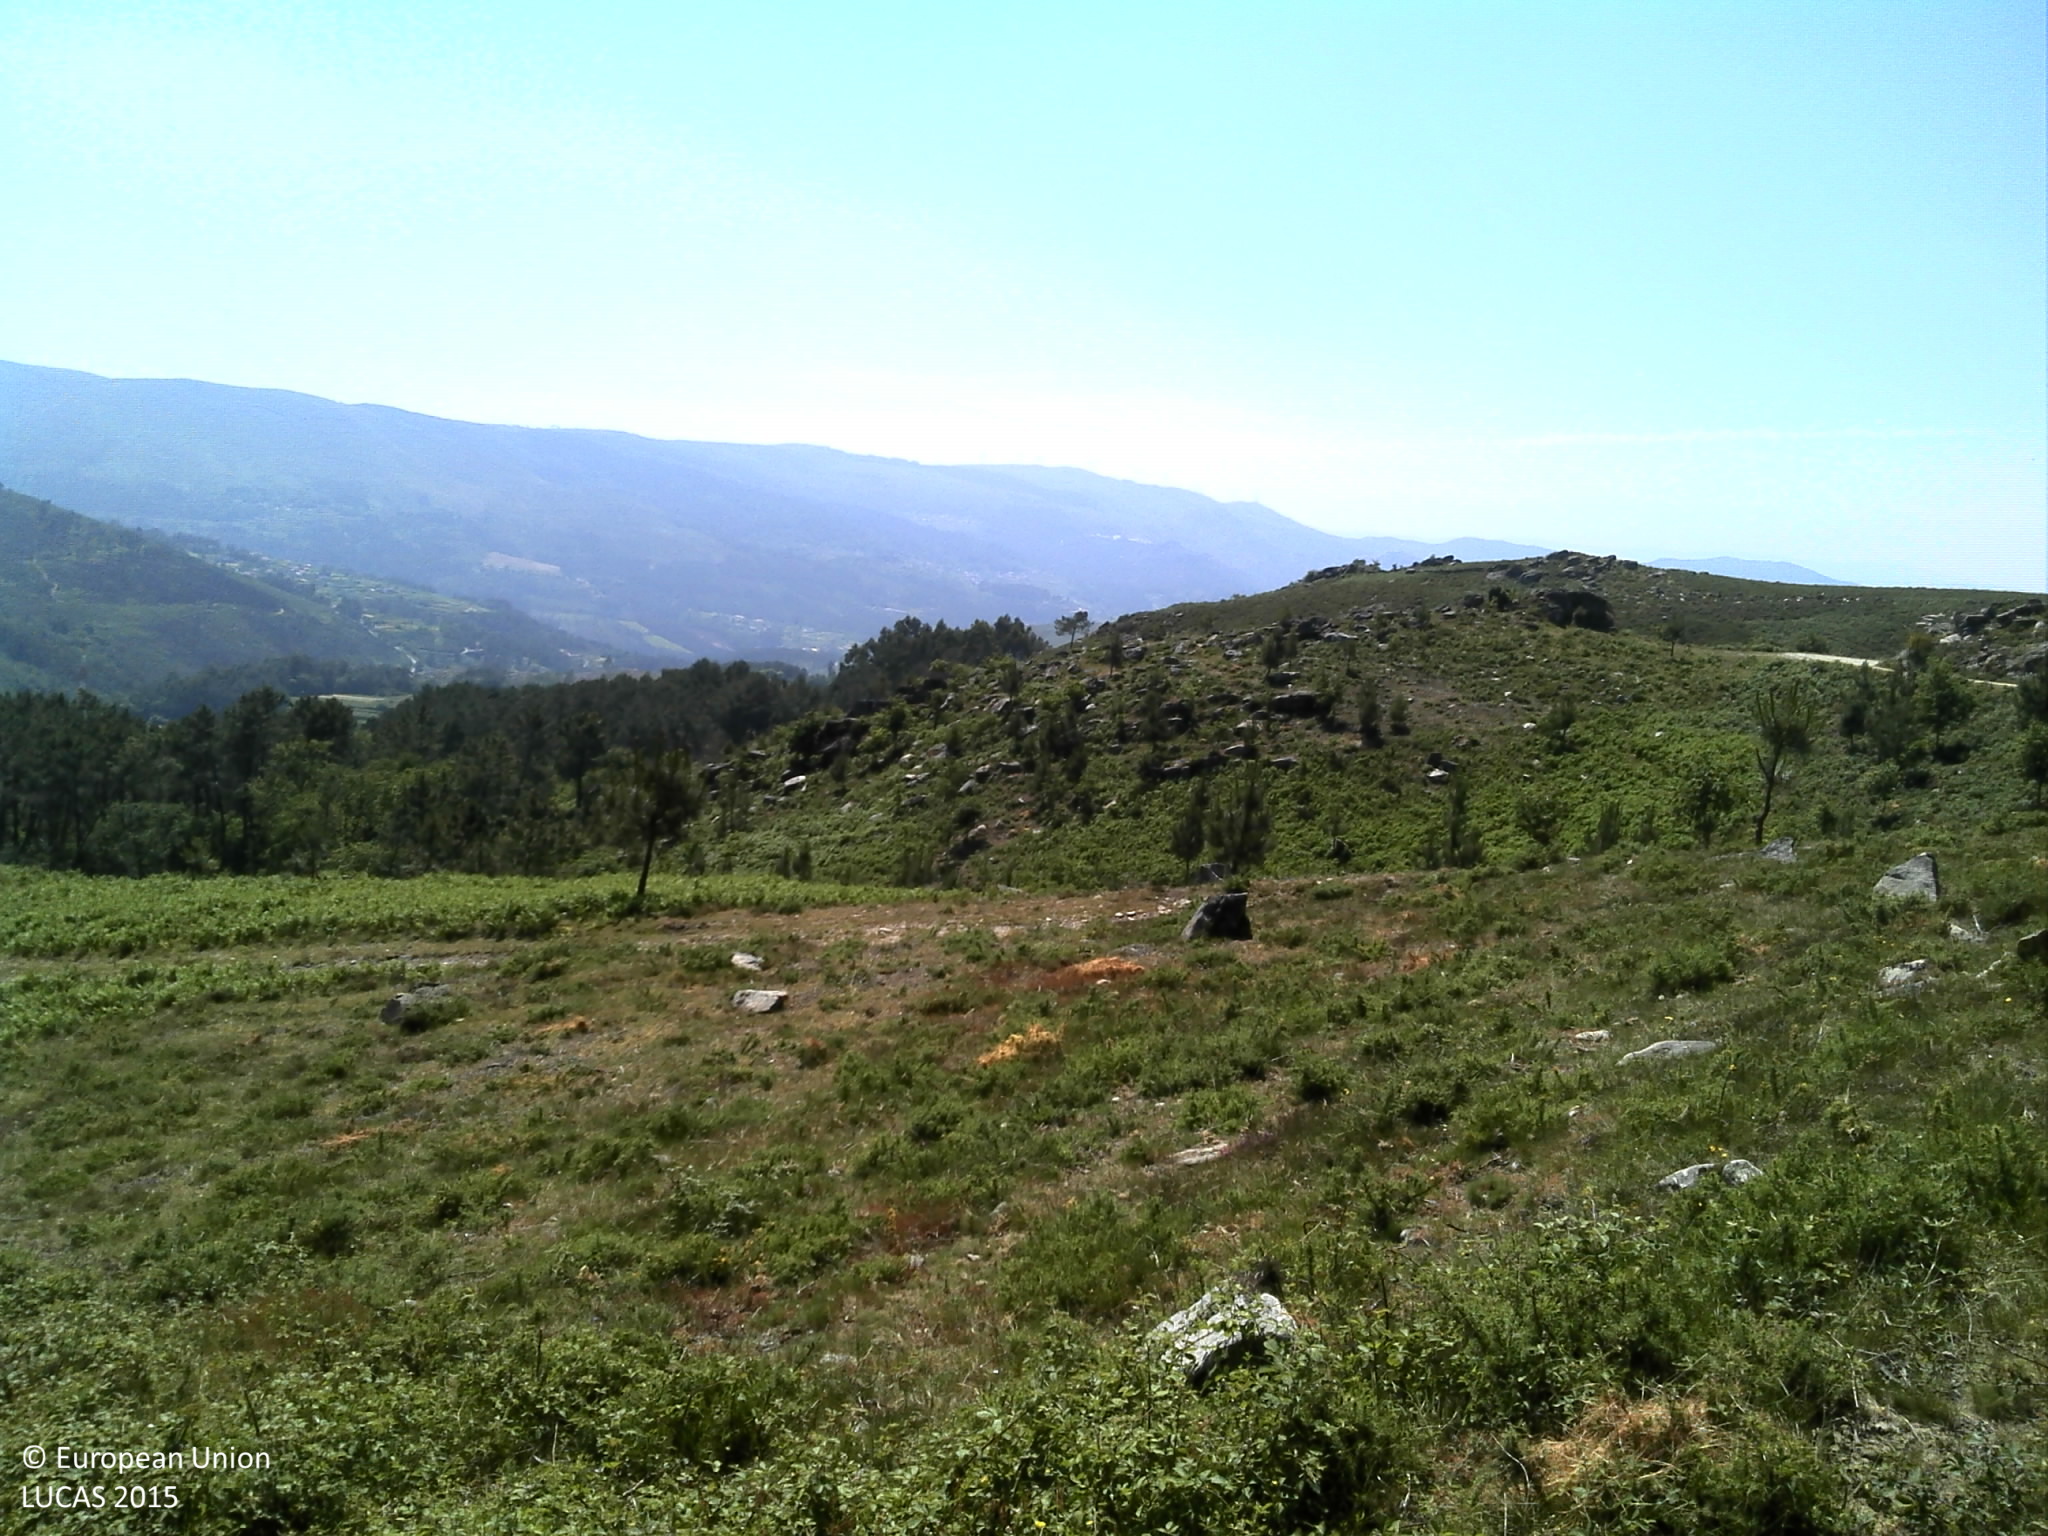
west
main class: Shrubland
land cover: Shrubland without tree cover
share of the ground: > 75 %
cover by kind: shrubs 80 %, herbaceous plants 10 %, unconsolidated bare surface 10 %
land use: Semi-natural and natural areas not in use
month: June
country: PT
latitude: 41.9991
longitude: -8.4270
